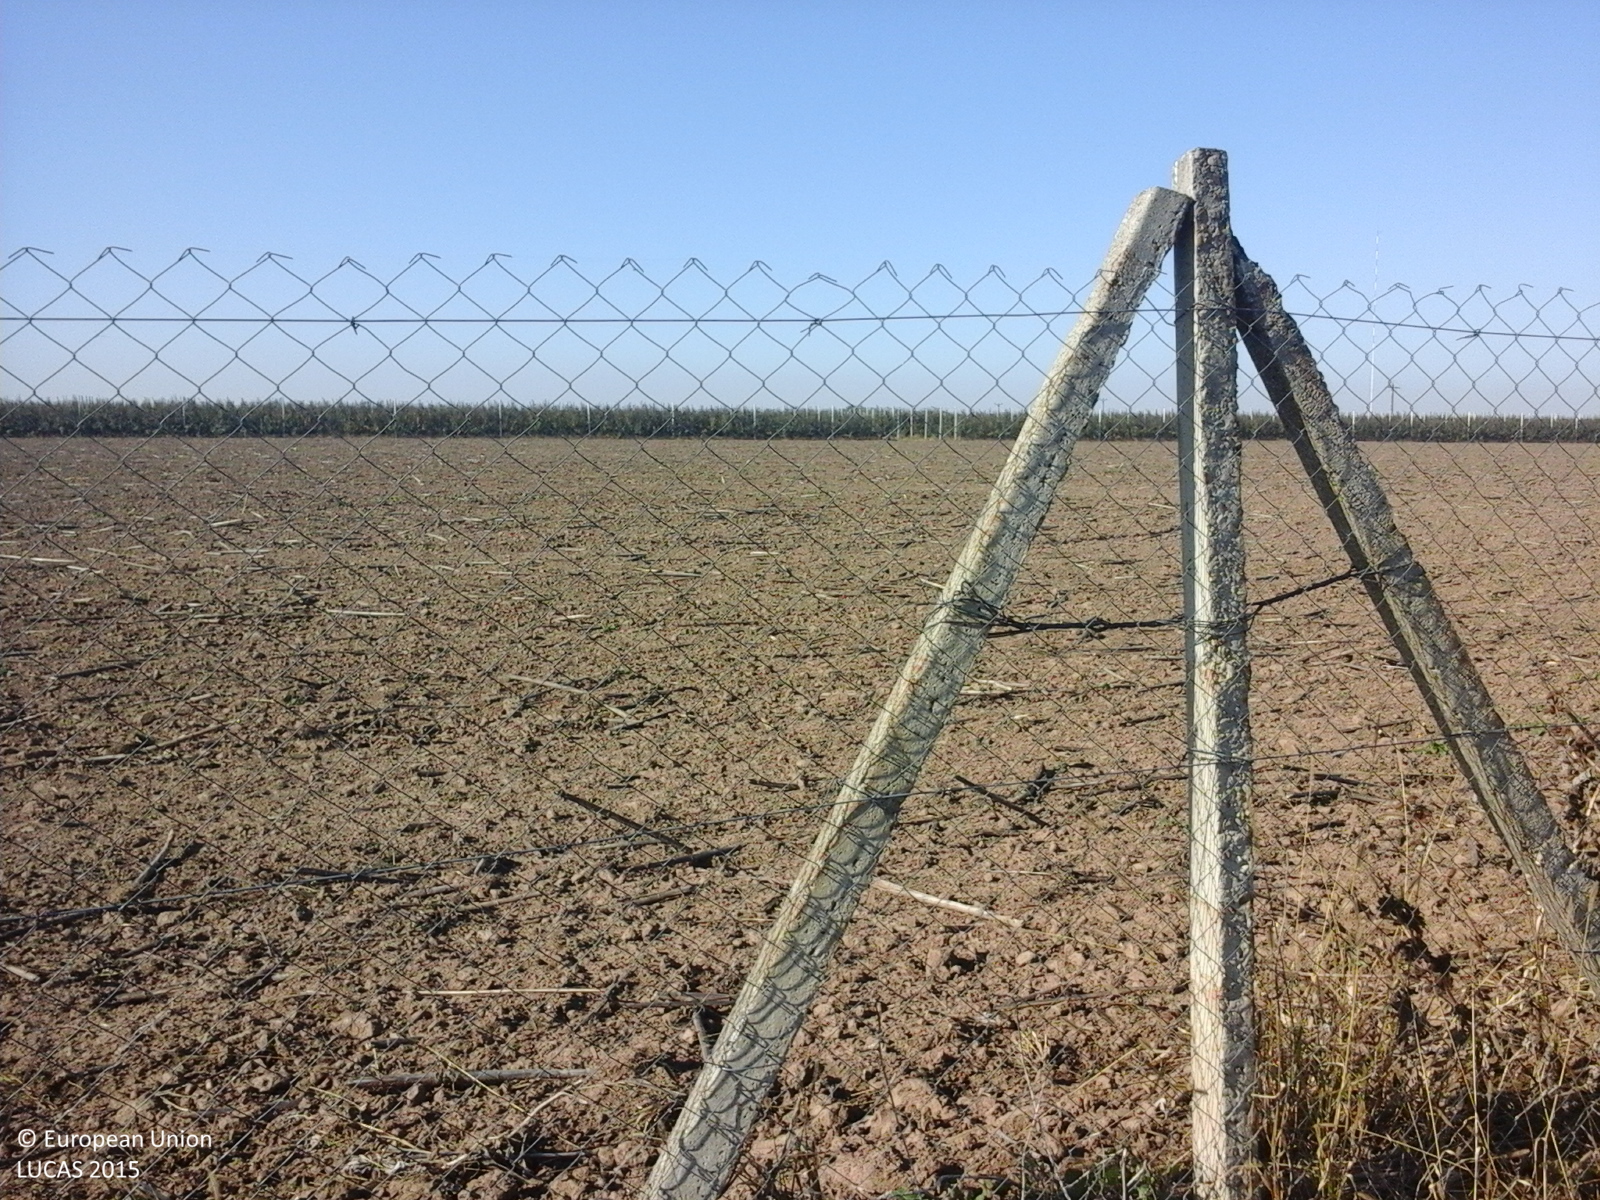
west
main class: Cropland
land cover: Sunflower
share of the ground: 10 - 25 %
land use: Agriculture (excluding fallow land and kitchen gardens)
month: October
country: RO
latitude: 45.9791
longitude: 27.1736
